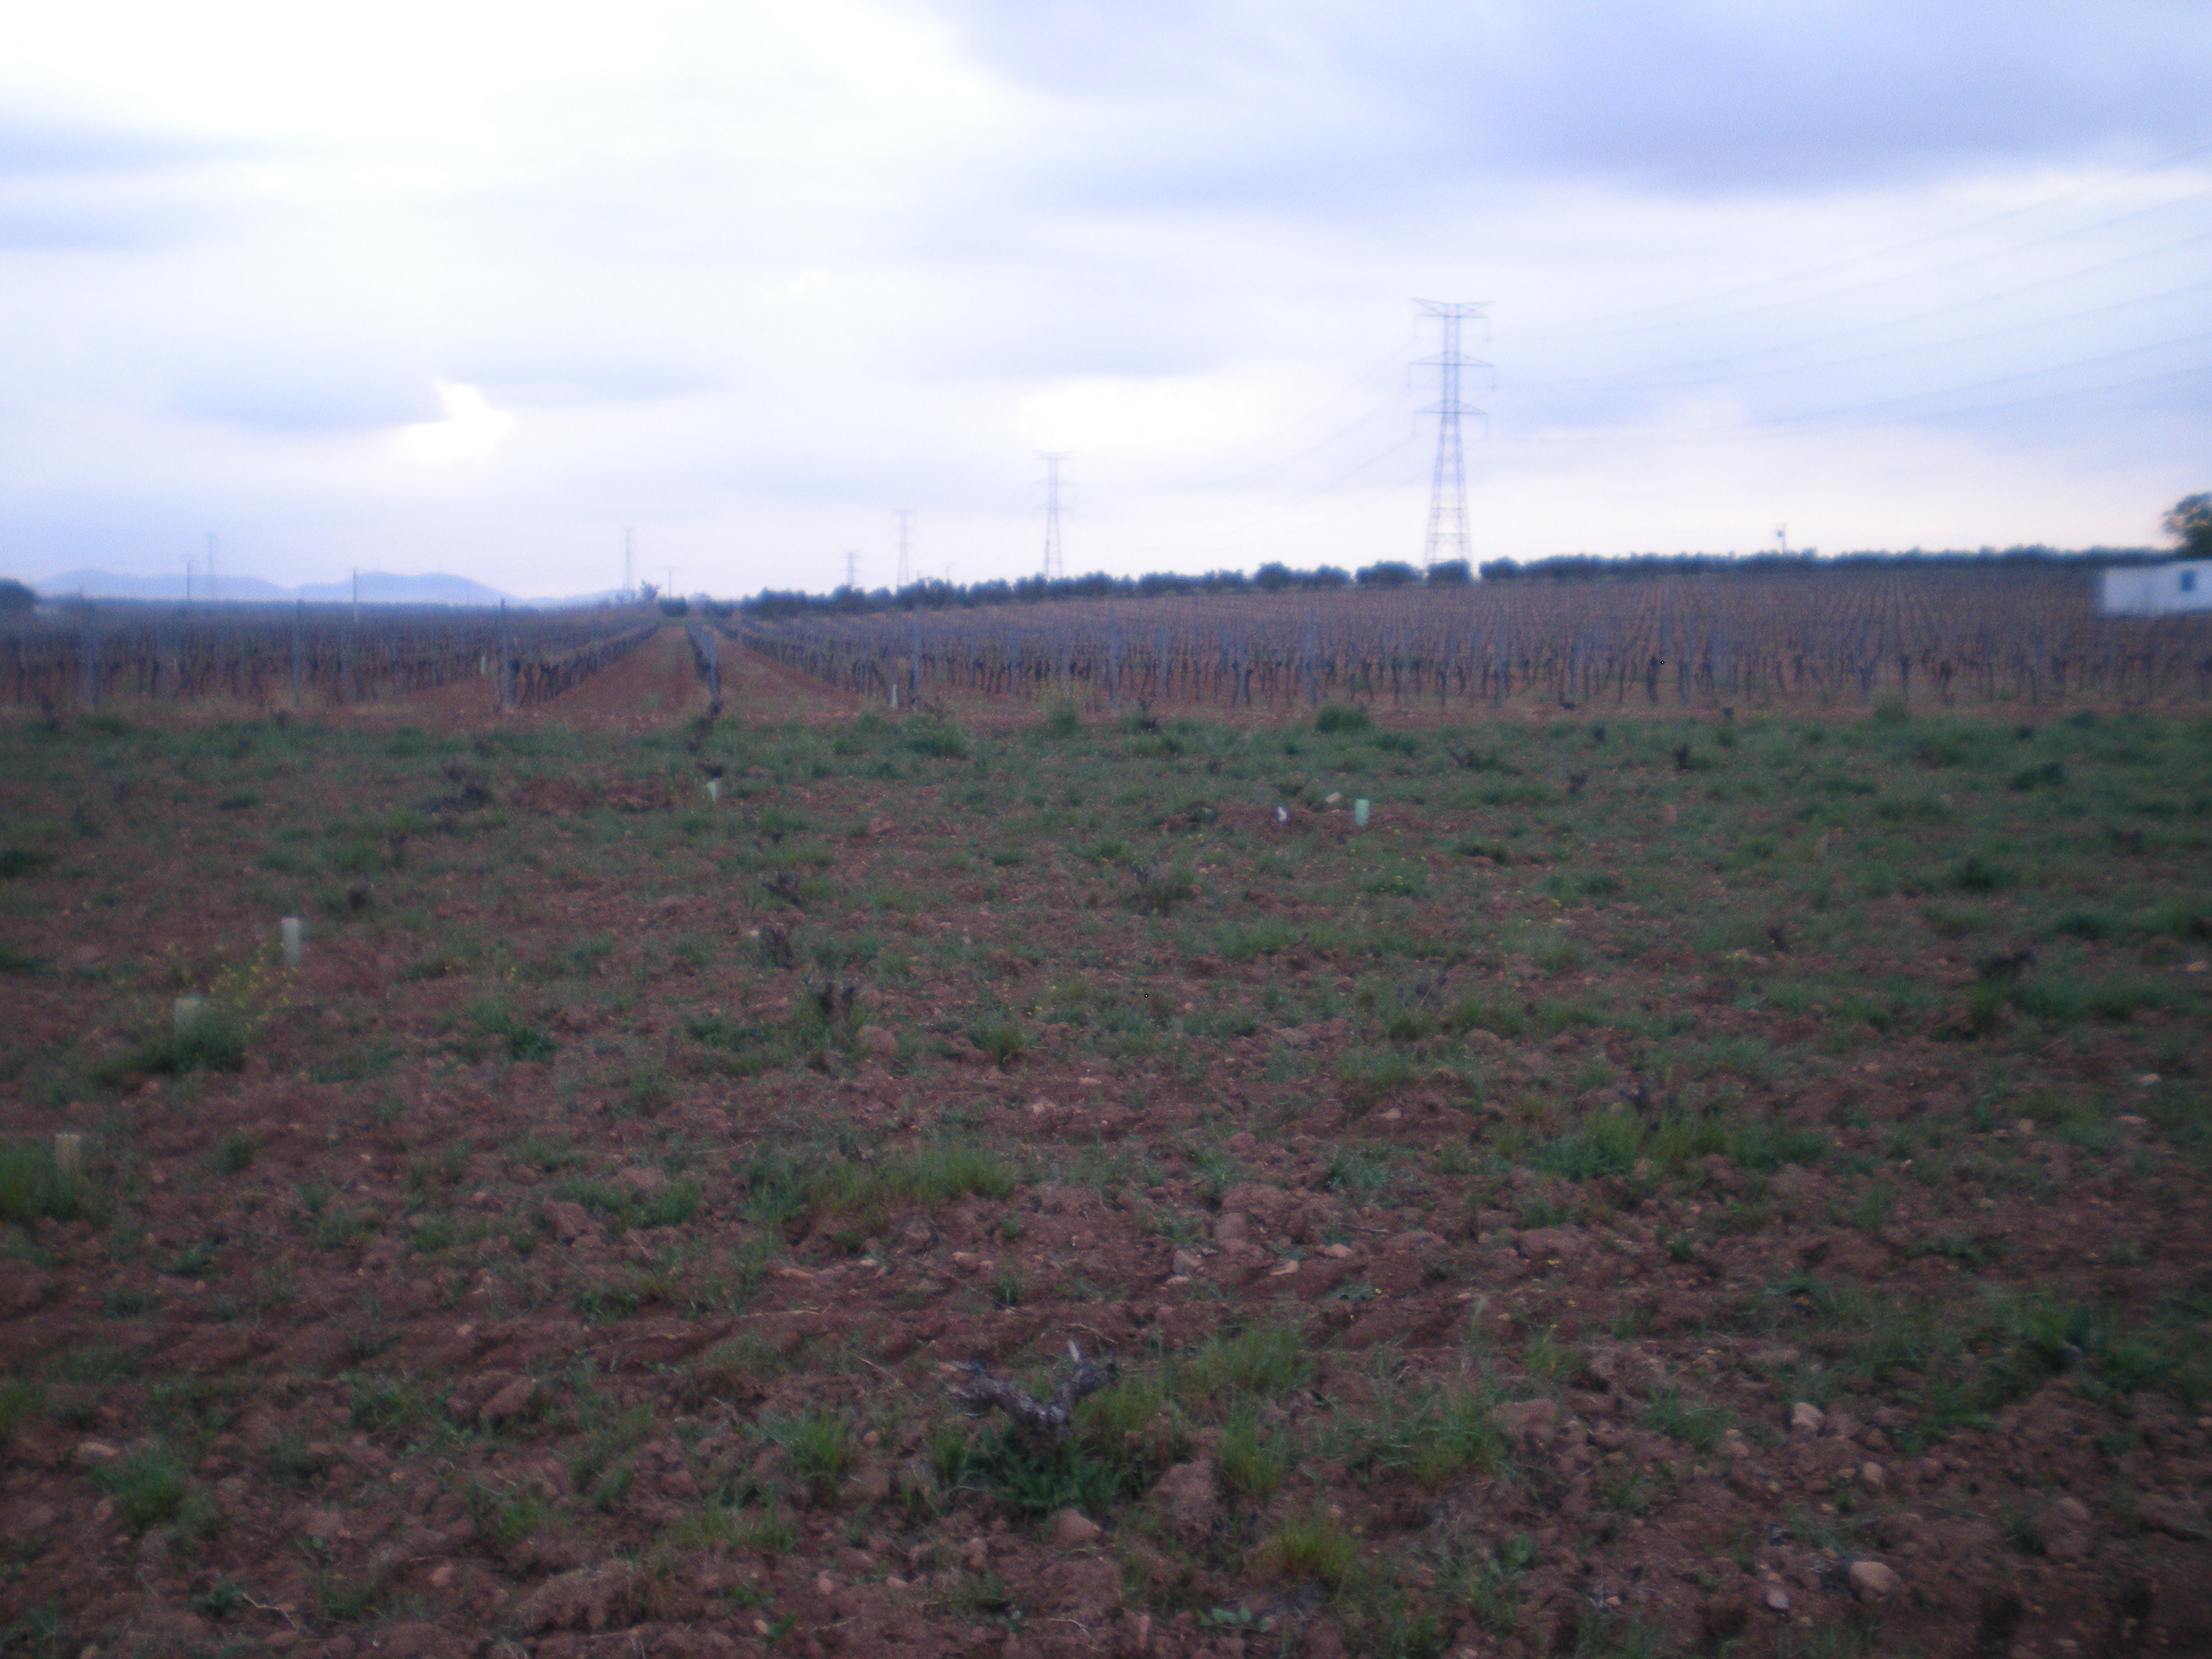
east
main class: Cropland
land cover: Vineyards
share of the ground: < 10 %
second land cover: Spontaneously vegetated surfaces
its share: 25 - 50 %
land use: Agriculture (excluding fallow land and kitchen gardens)
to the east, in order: Vineyards; Spontaneously vegetated surfaces
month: April
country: ES
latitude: 38.7809
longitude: -3.4921
